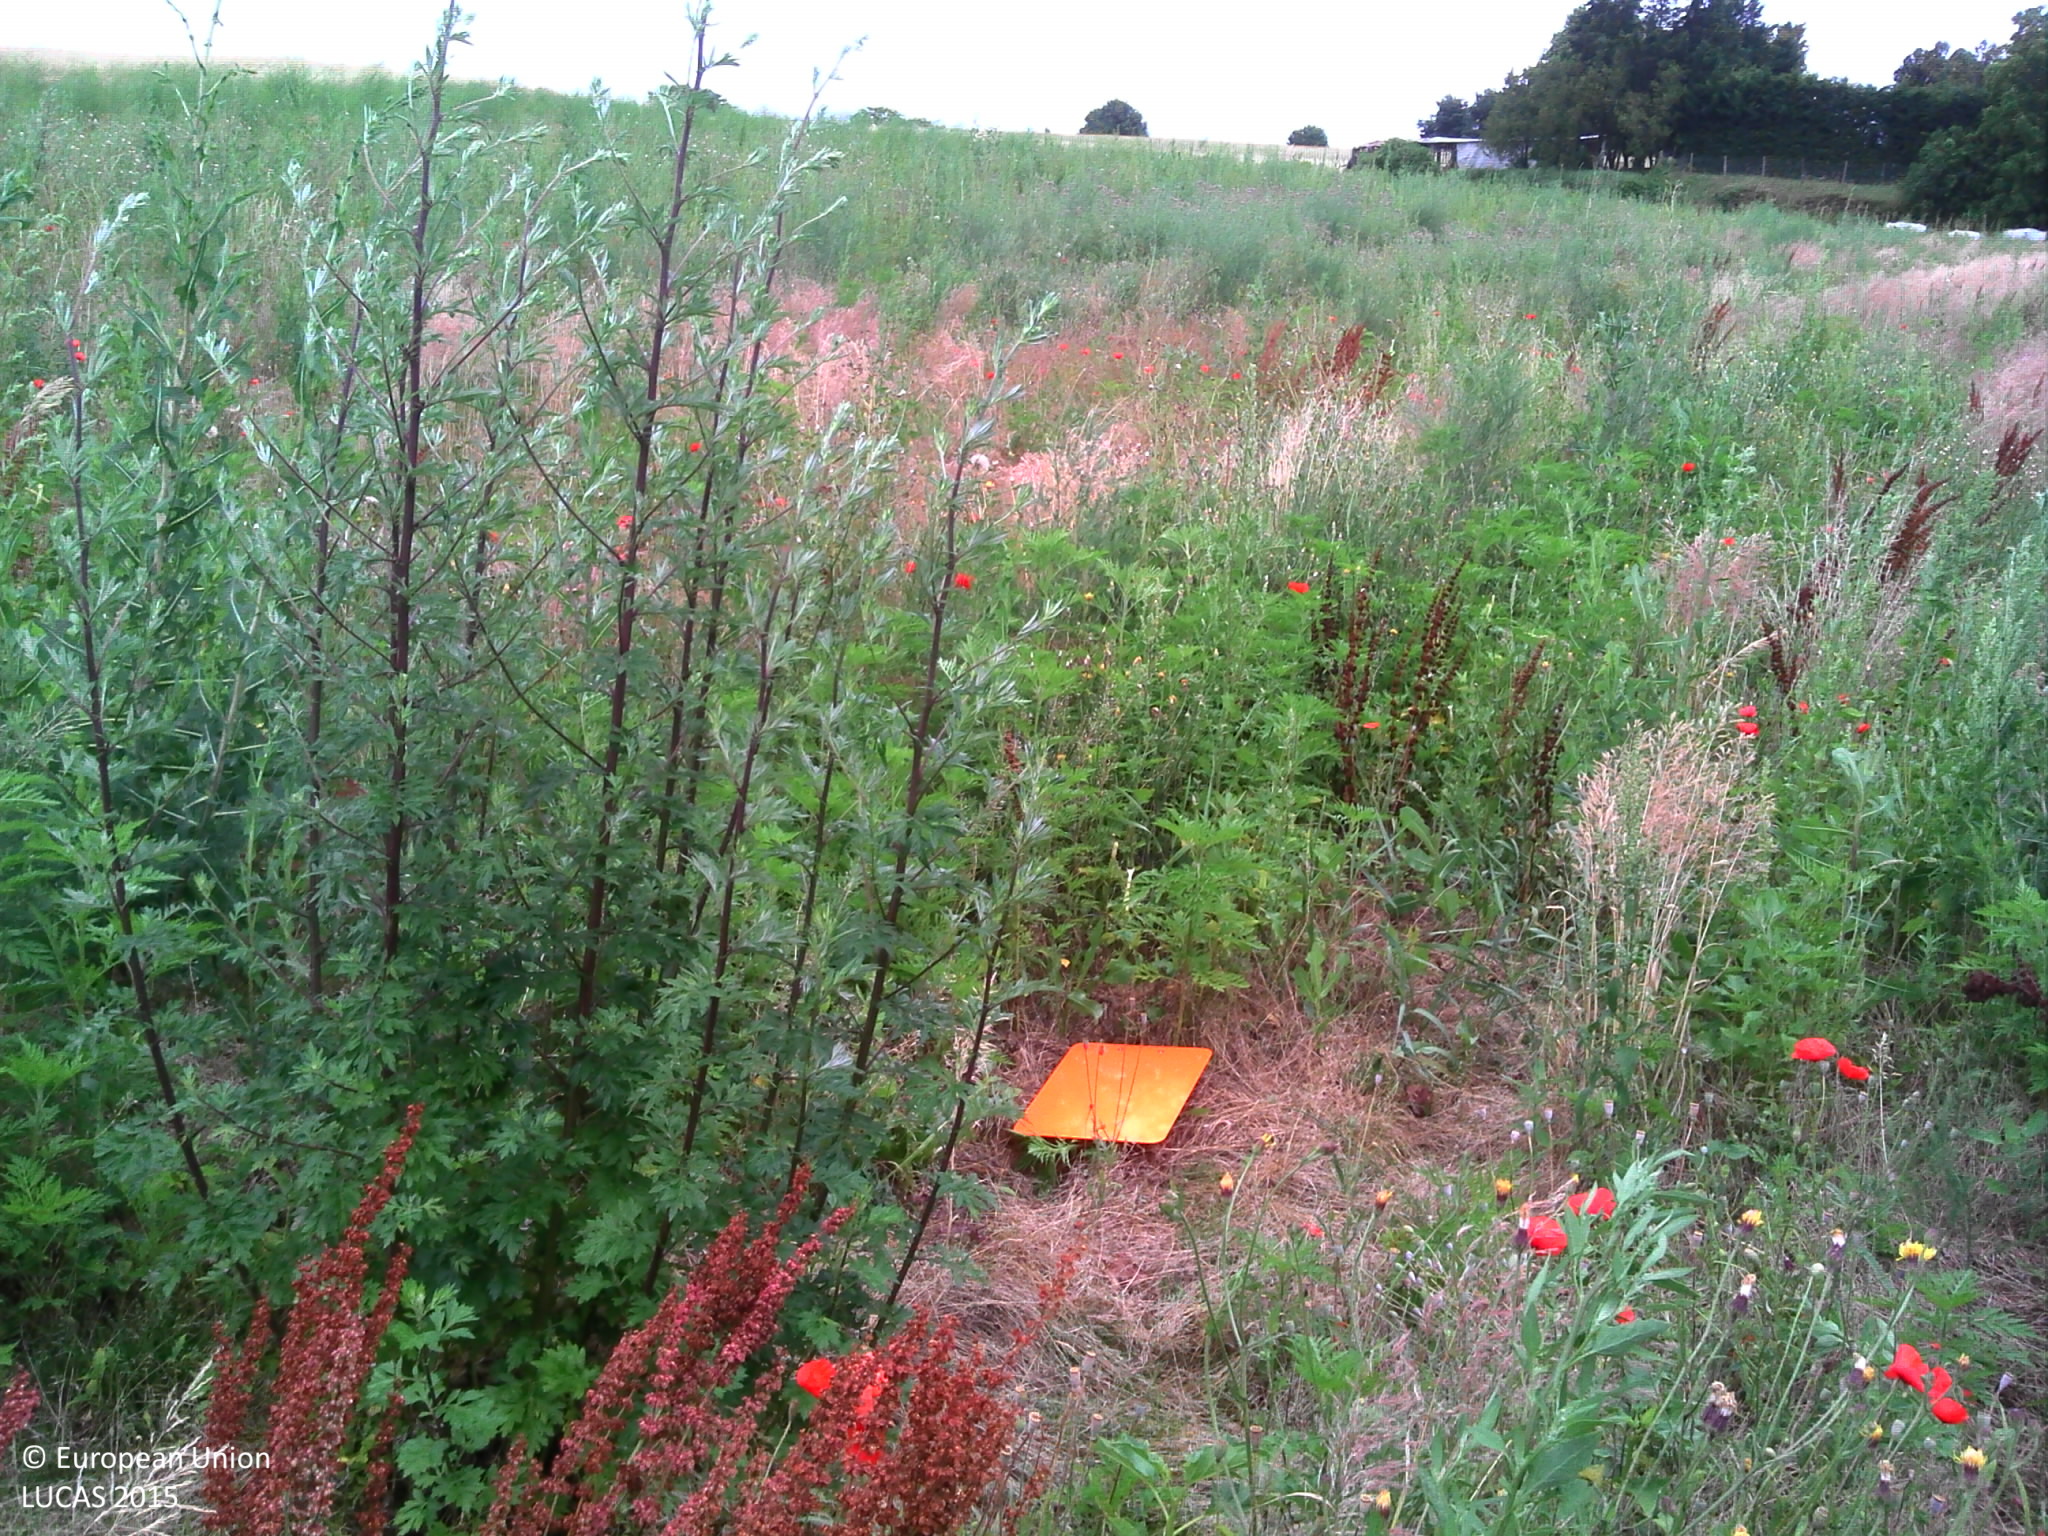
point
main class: Grassland
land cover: Spontaneously vegetated surfaces
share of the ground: > 75 %
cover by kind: herbaceous plants 100 %
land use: Agriculture (excluding fallow land and kitchen gardens)
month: June
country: FR
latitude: 45.1348
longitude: 5.0334
